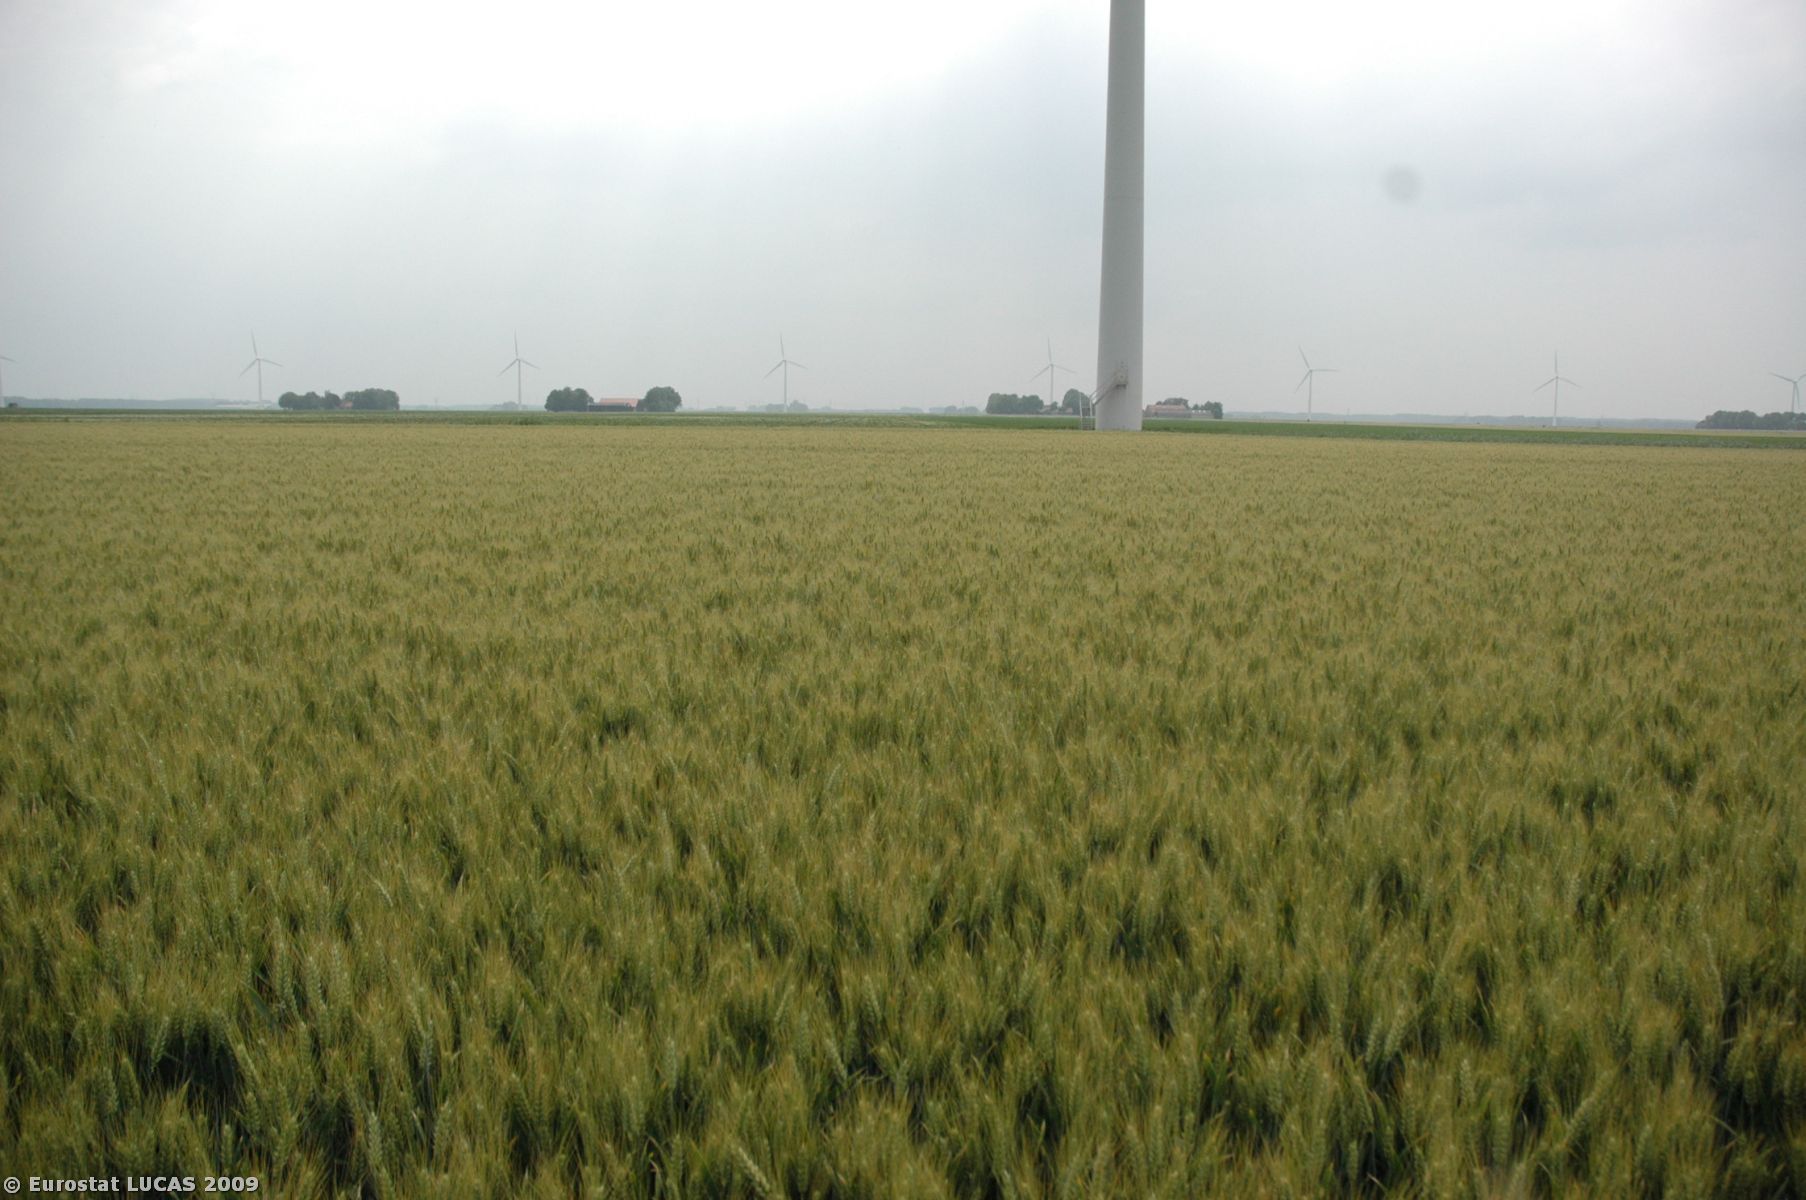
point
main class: Cropland
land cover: Common wheat
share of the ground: > 75 %
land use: Agriculture (excluding fallow land and kitchen gardens)
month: June
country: NL
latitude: 52.4601
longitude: 5.6570
